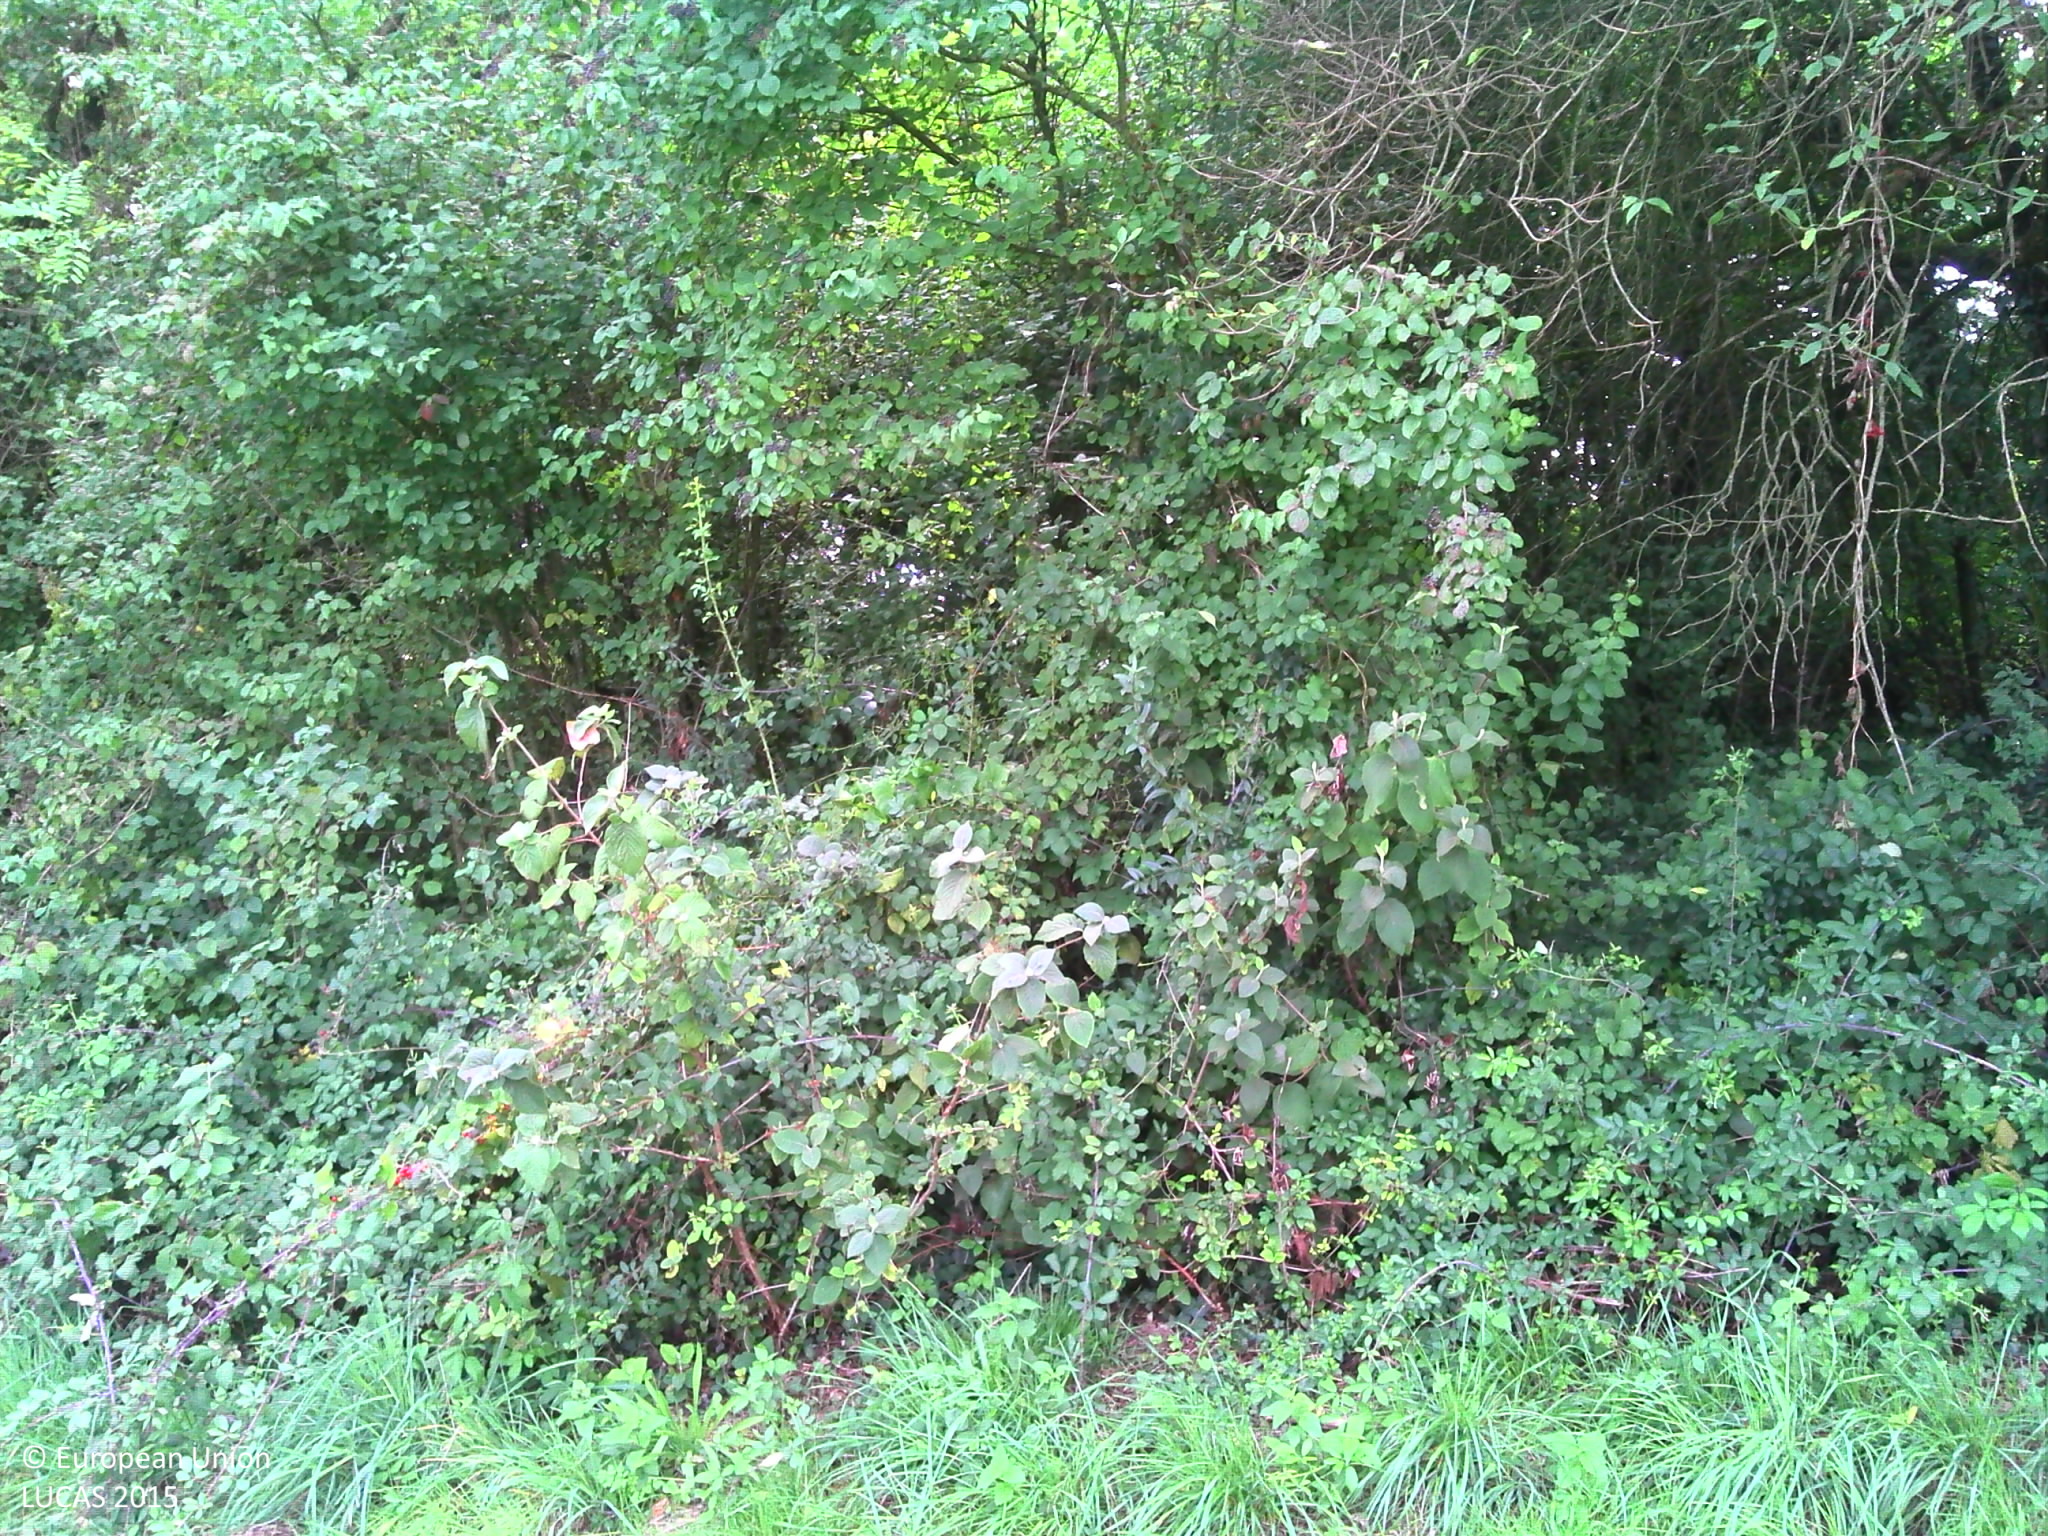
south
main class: Grassland
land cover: Grassland without tree/shrub cover
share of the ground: > 75 %
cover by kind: herbaceous plants 80 %, lichens and mosses 20 %
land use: Agriculture (excluding fallow land and kitchen gardens)
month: August
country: FR
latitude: 45.2918
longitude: 0.4887
